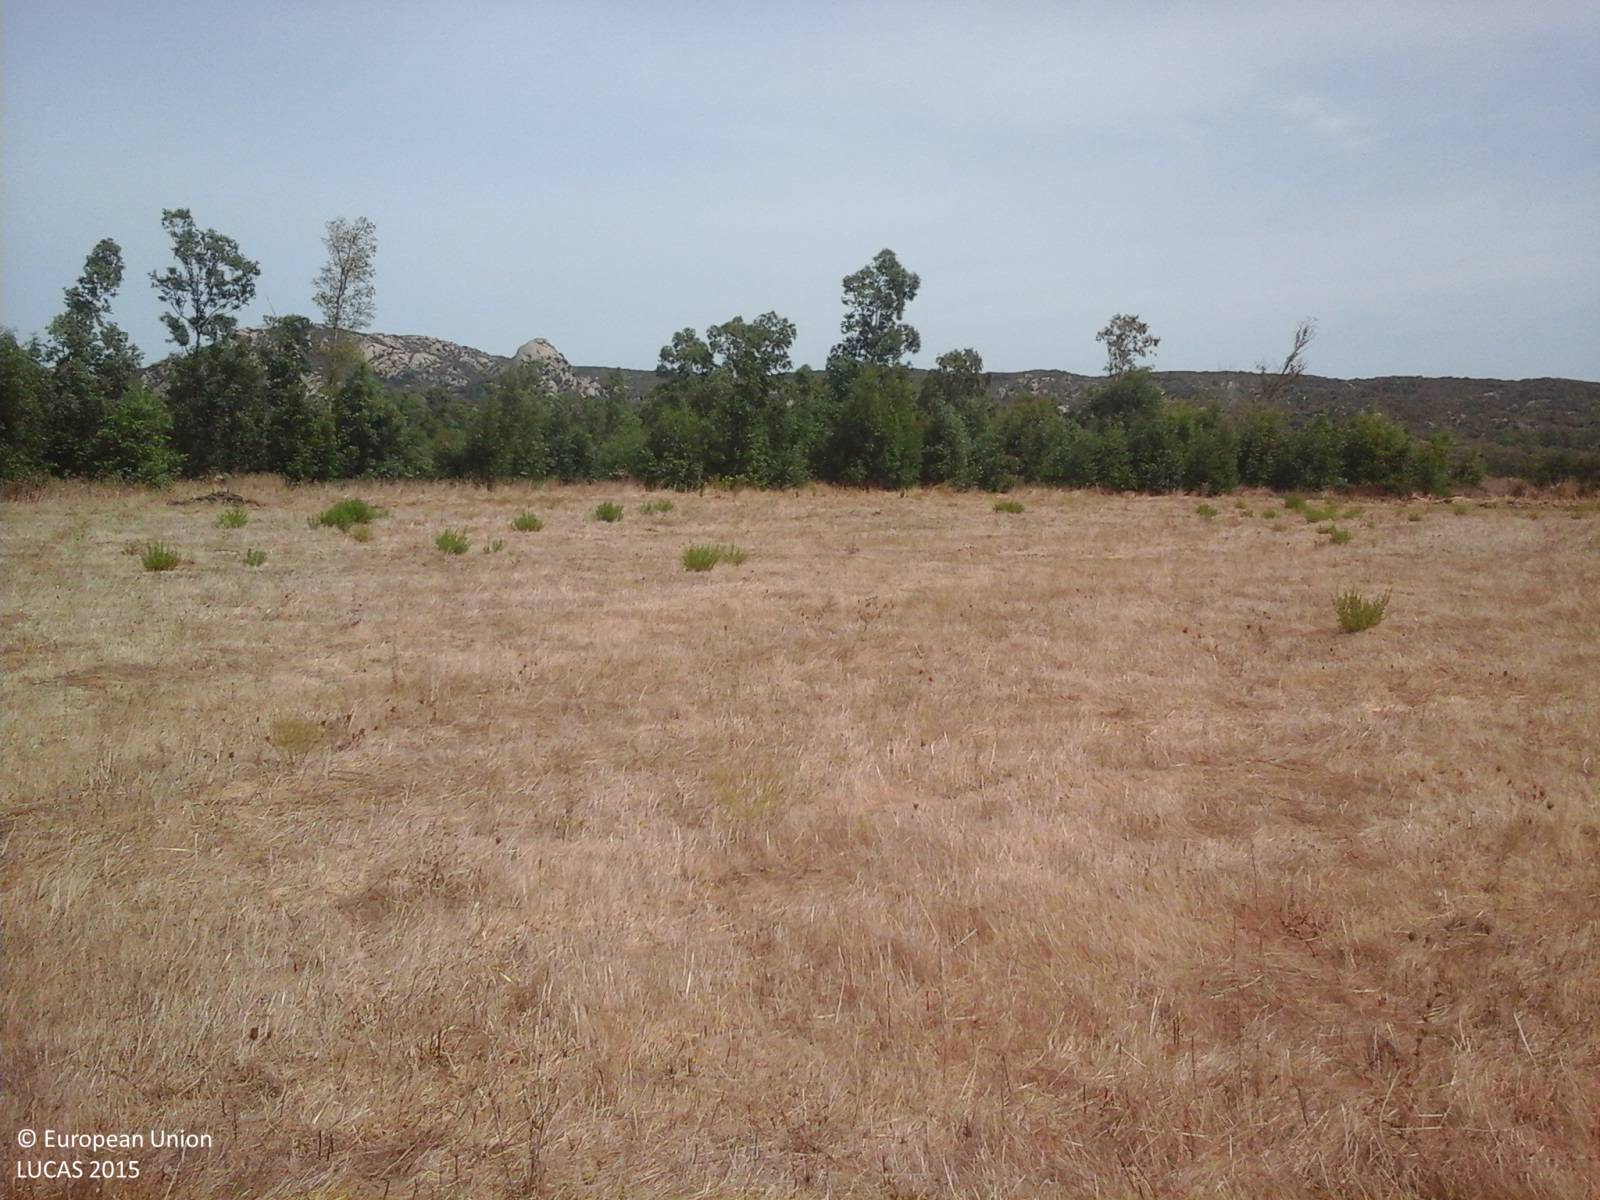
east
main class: Grassland
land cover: Grassland without tree/shrub cover
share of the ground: > 75 %
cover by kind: herbaceous plants 95 %, shrubs 5 %
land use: Agriculture (excluding fallow land and kitchen gardens)
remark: Harvested field
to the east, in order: Grassland without tree/shrub cover; Lines of trees; Shrubland without tree cover; Grassland without tree/shrub cover; Shrubland without tree cover; Lines of trees; Grassland without tree/shrub cover
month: September
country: IT
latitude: 41.0800
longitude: 9.4431
